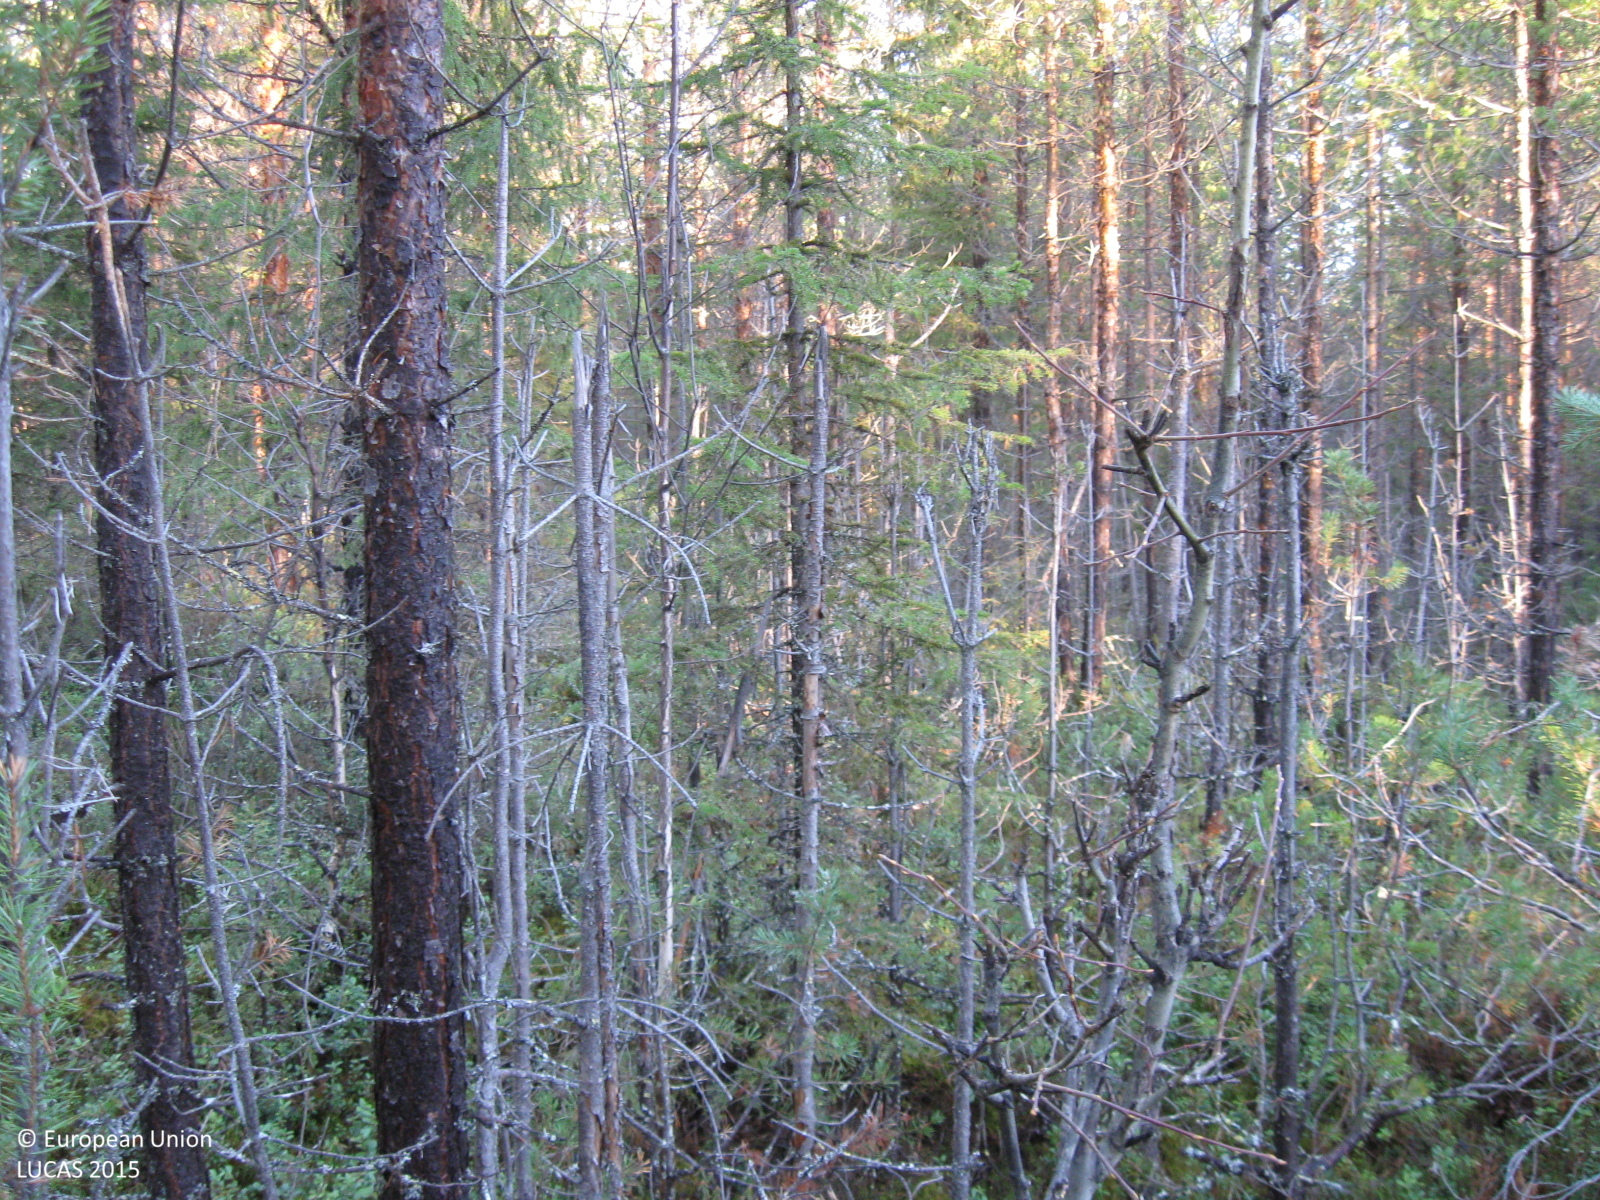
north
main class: Woodland
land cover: Pine dominated coniferous woodland
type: boreal forest
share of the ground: > 75 %
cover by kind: coniferous forest trees 80 %, broadleaved forest trees 5 %, shrubs 5 %, herbaceous plants 5 %, lichens and mosses 5 %
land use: Forestry
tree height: > 5 m
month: November
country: SE
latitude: 66.1640
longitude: 20.8503
